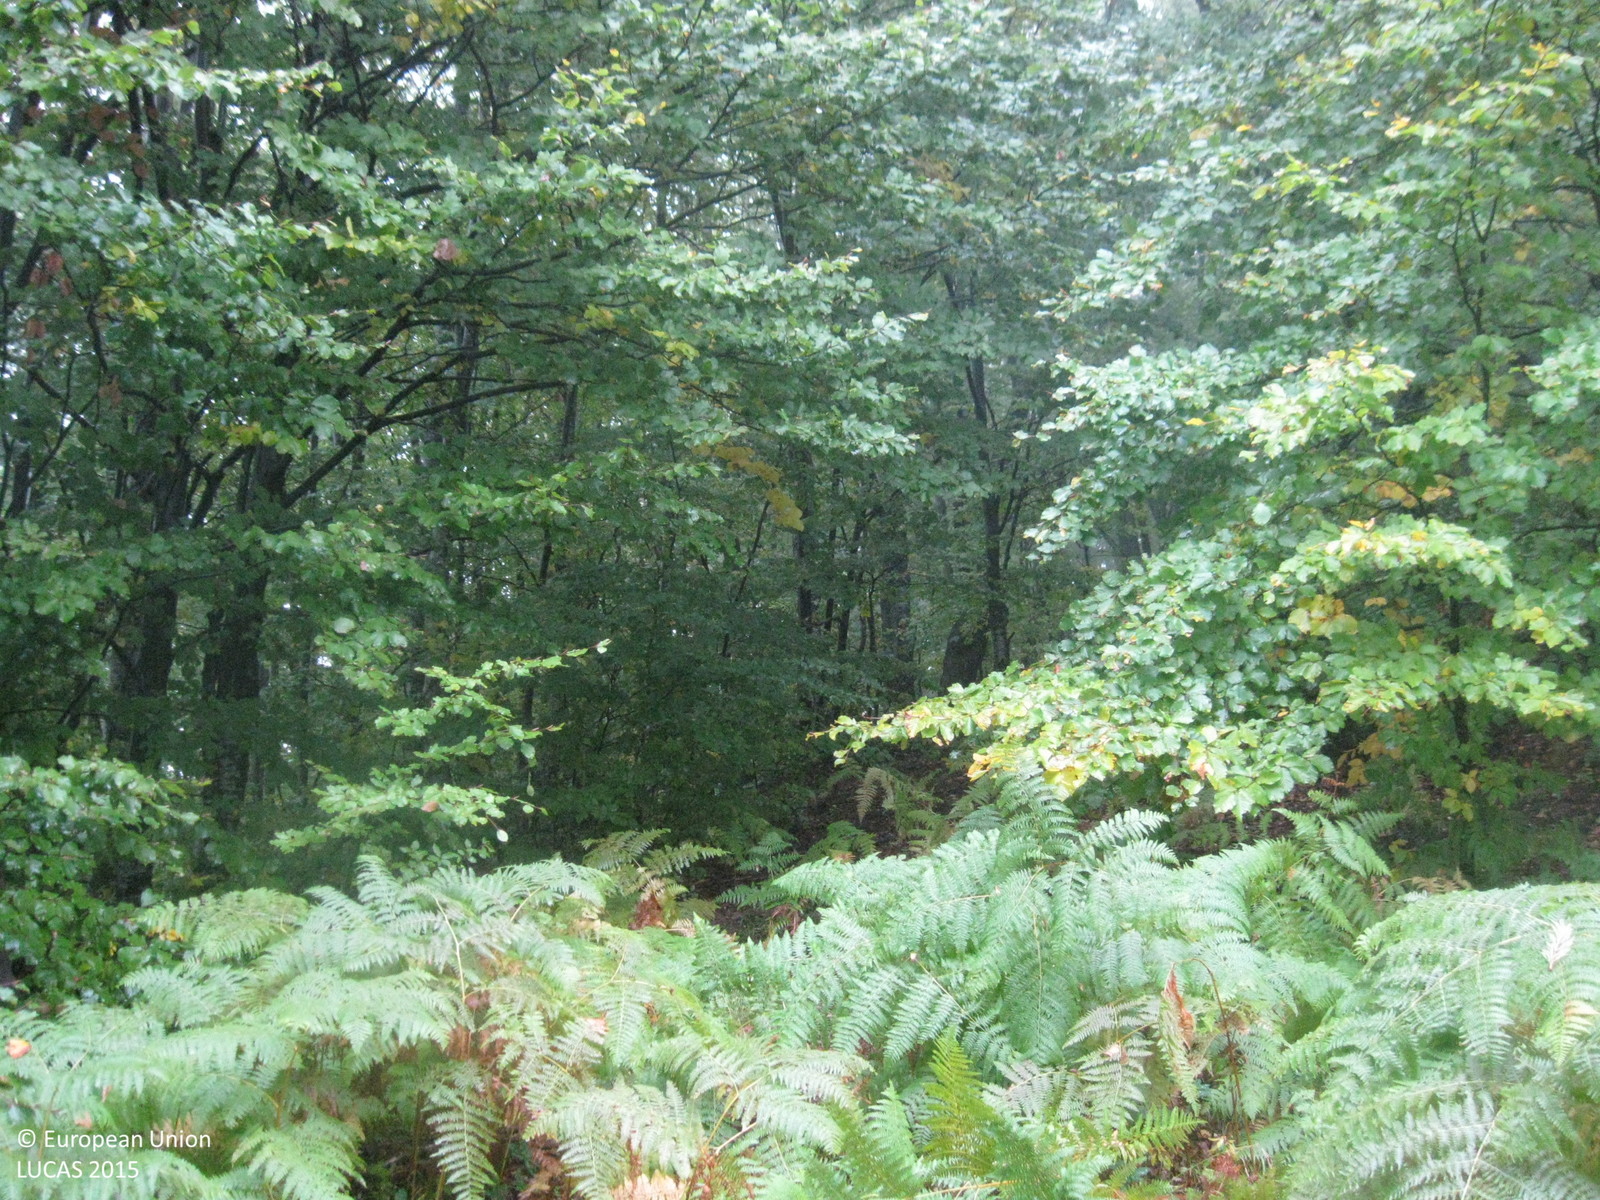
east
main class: Woodland
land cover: Broadleaved woodland
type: mesophytic deciduous forest
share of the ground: > 75 %
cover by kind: broadleaved forest trees 95 %, shrubs 5 %
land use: Forestry
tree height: > 5 m
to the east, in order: Broadleaved woodland
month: October
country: BG
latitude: 41.8418
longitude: 24.9977
